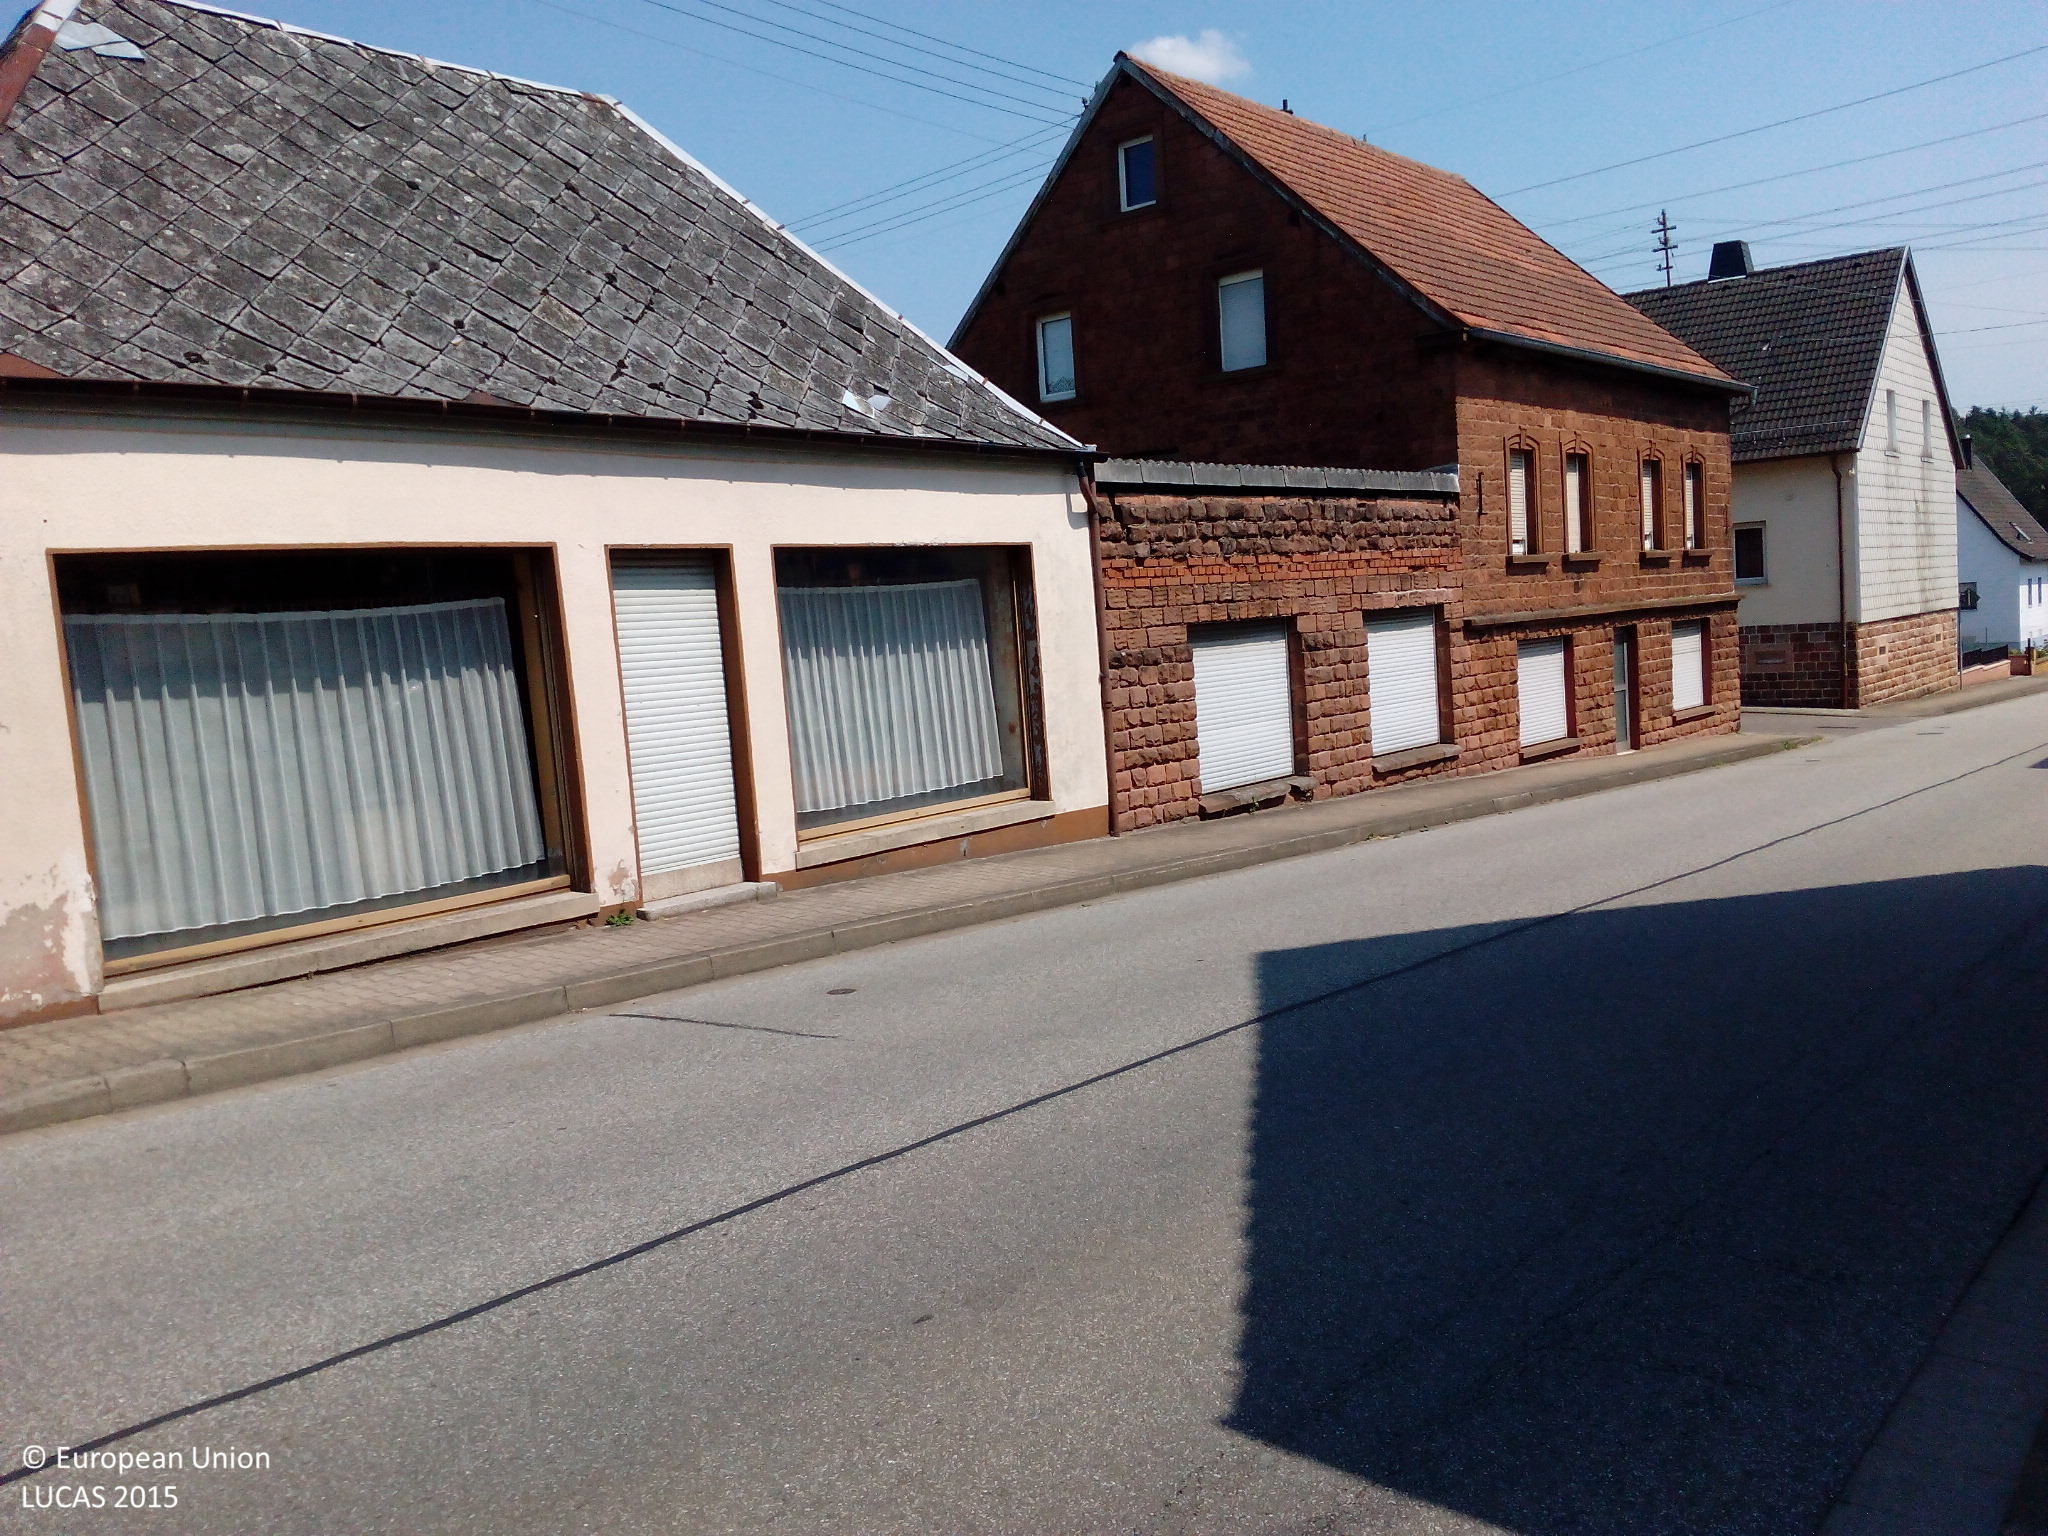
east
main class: Shrubland
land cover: Shrubland without tree cover
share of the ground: > 75 %
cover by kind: herbaceous plants 70 %, shrubs 20 %, unconsolidated bare surface 10 %
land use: Residential
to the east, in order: Shrubland without tree cover; Artificial constructions in urban areas; Grassland without tree/shrub cover
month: July
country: DE
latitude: 49.4564
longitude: 7.5586
